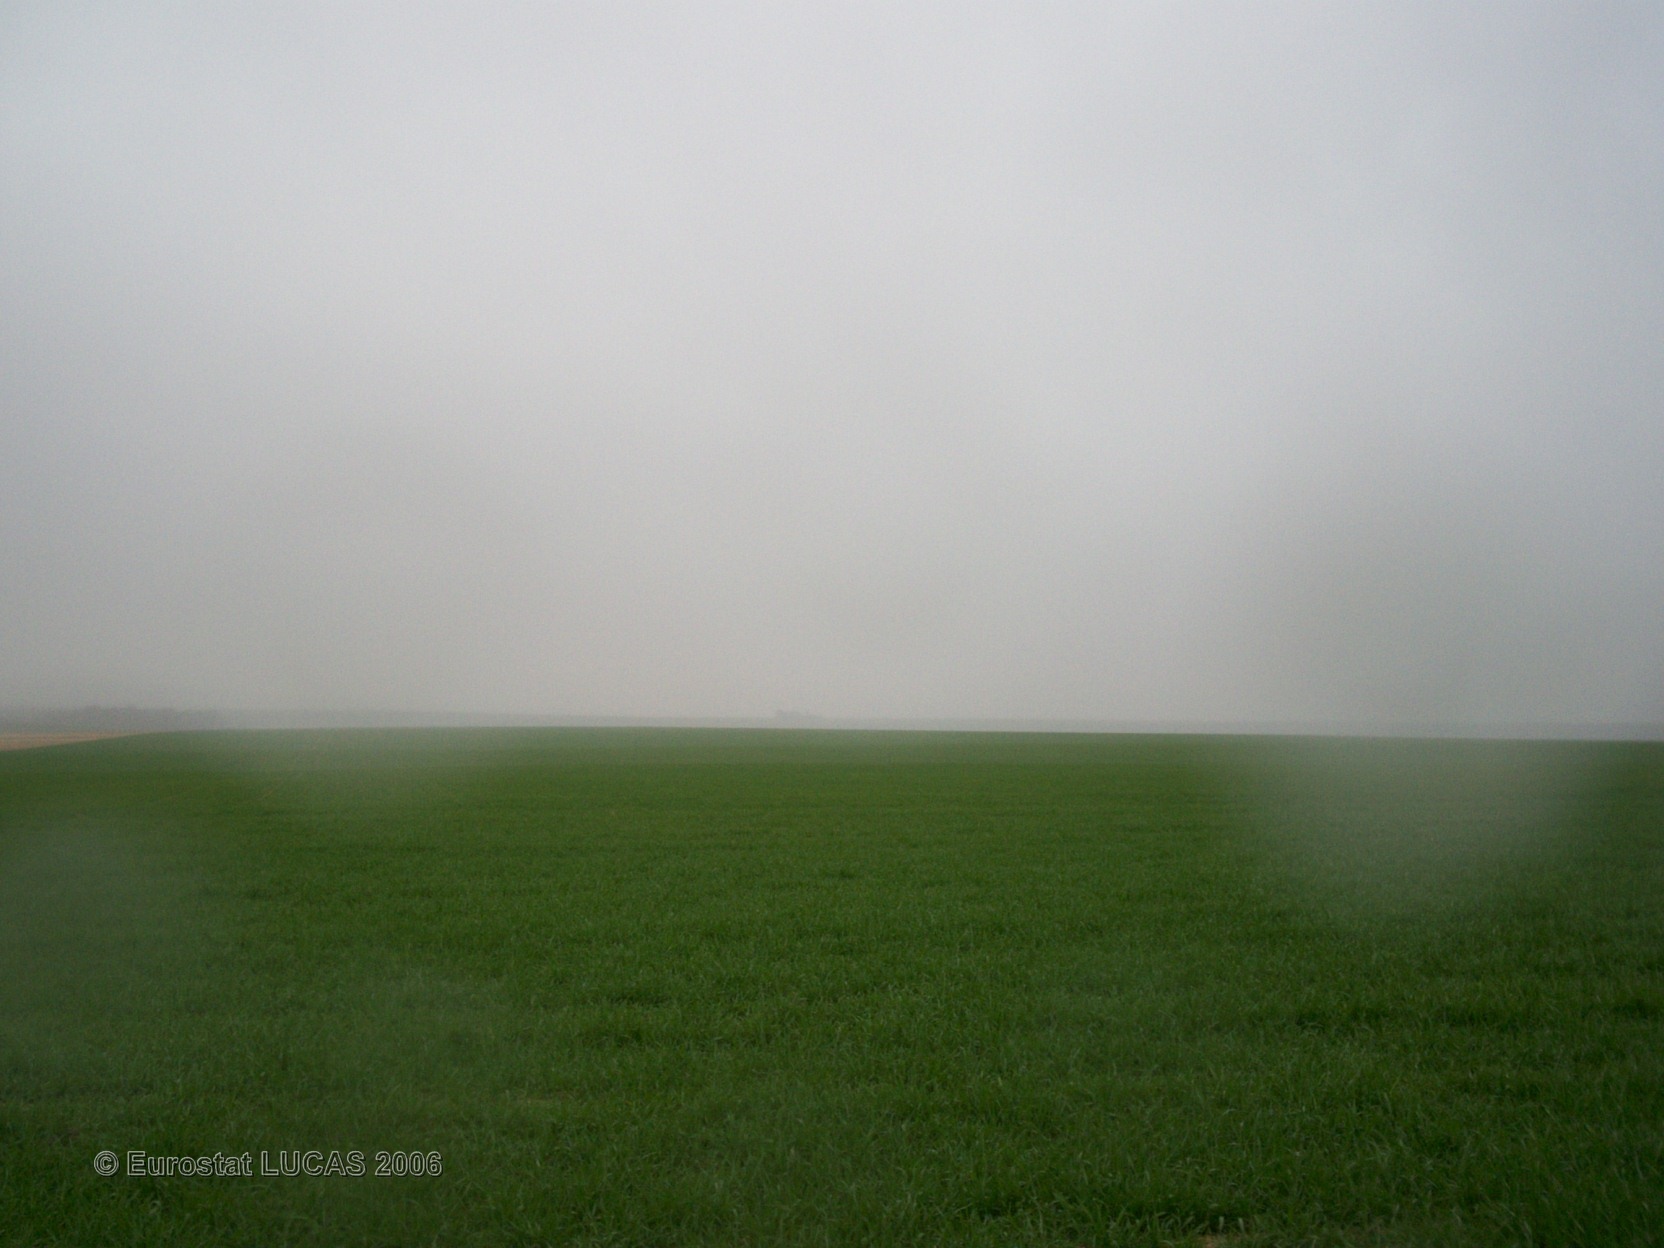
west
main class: Cropland
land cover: Common wheat
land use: Agriculture (excluding fallow land and kitchen gardens)
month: April
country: FR
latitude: 49.2564
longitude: 4.4592
